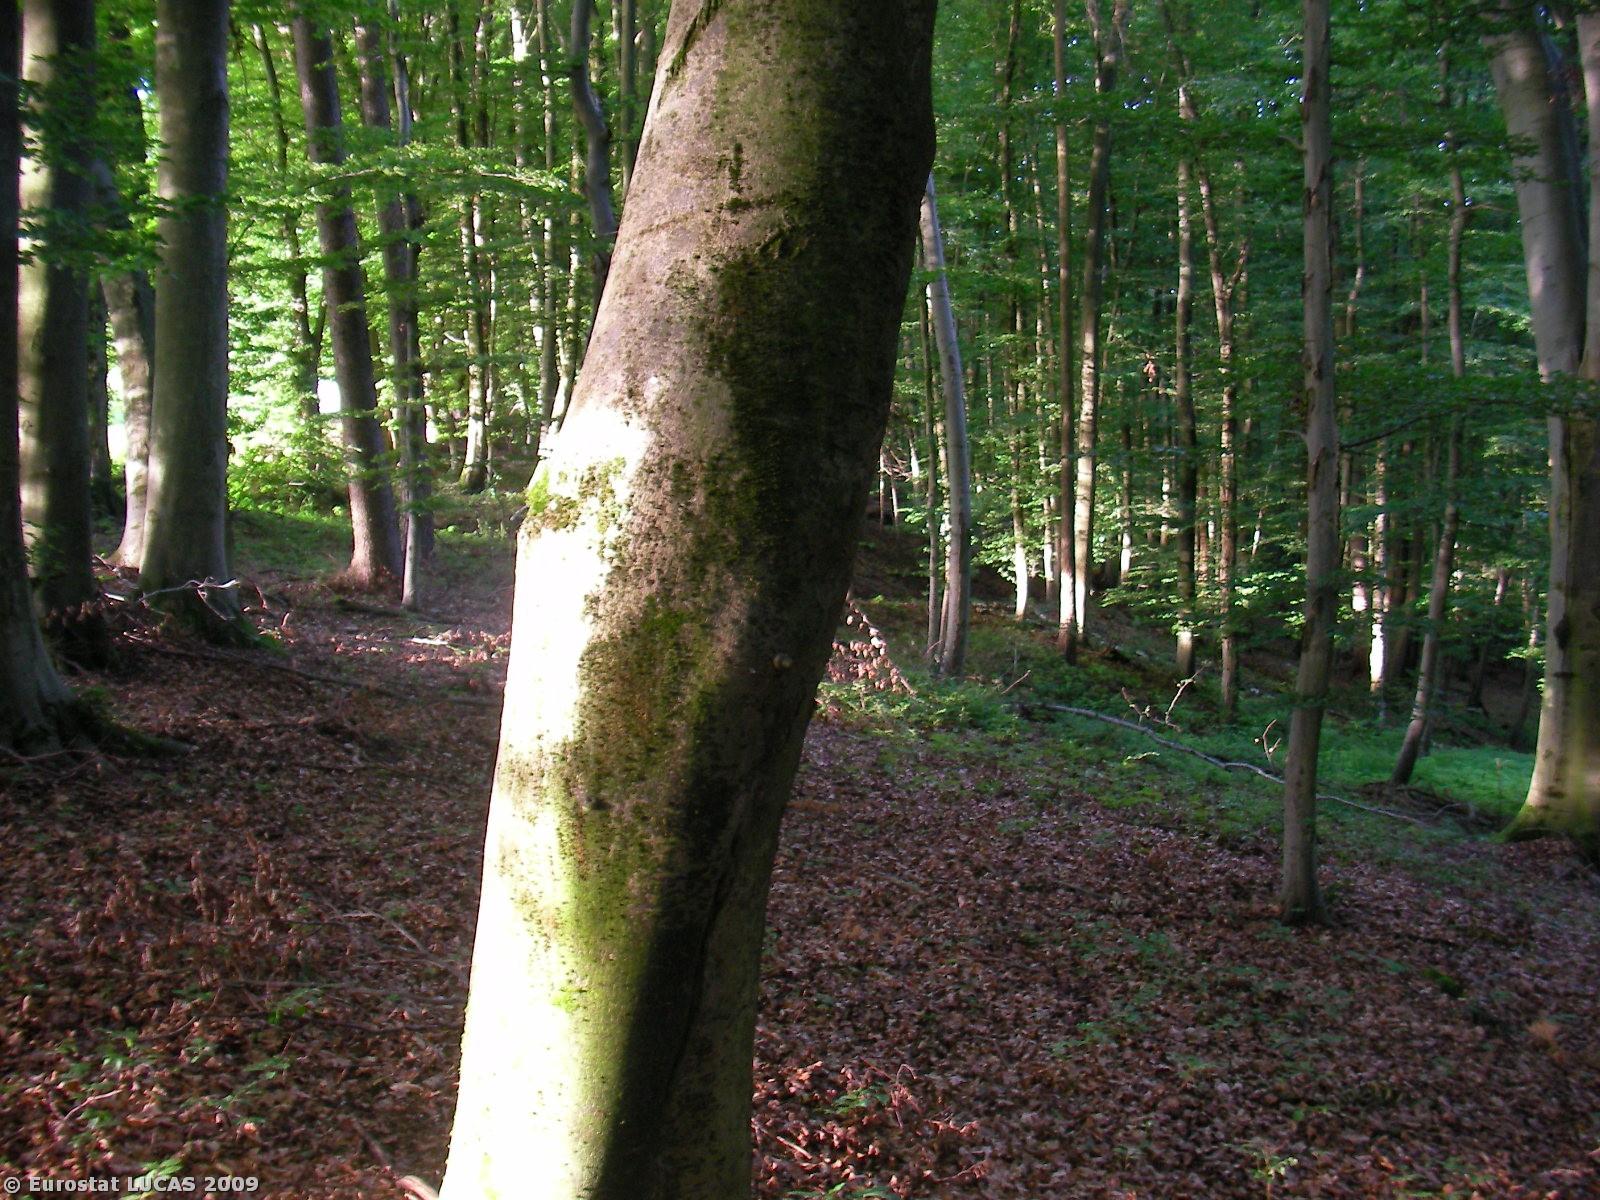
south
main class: Woodland
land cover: Broadleaved woodland
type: hemiboreal forest and nemoral coniferous forest and mixed broadleaved-coniferous forest
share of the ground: > 75 %
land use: Forestry
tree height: > 5 m
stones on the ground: < 10 %
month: June
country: AT
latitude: 47.0006
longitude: 15.5630
